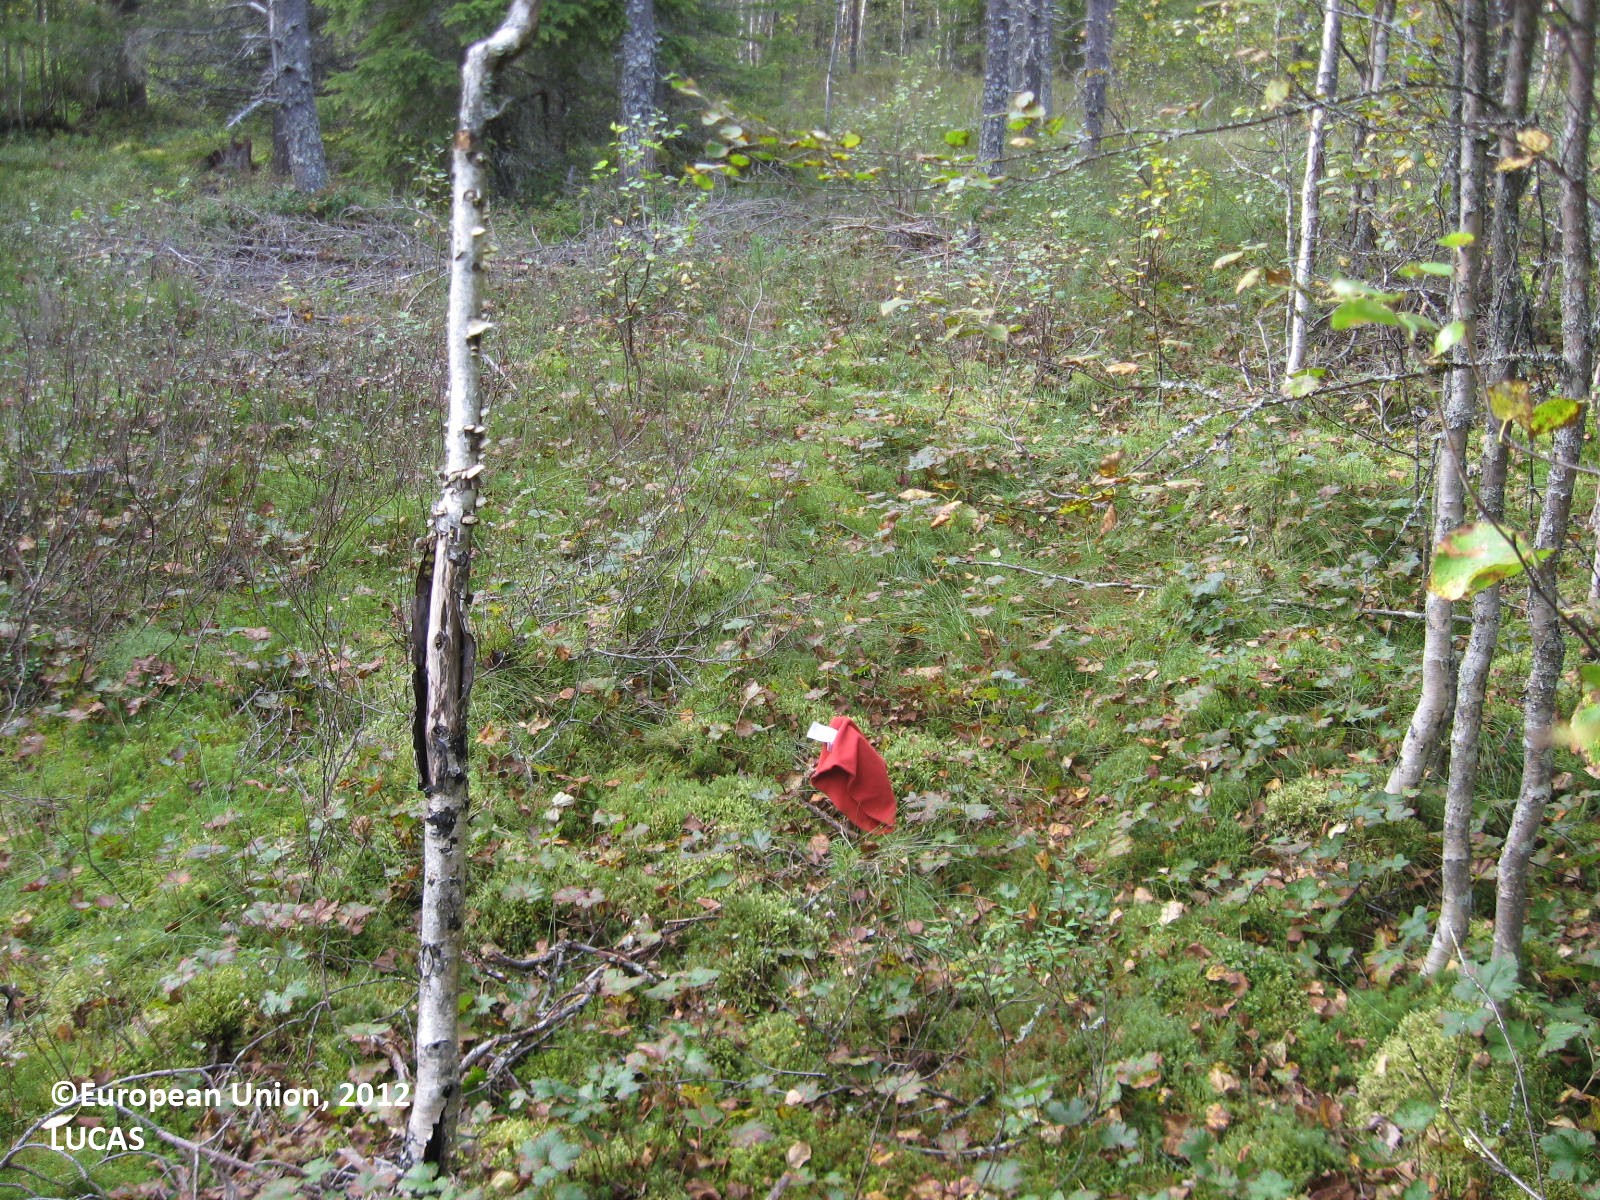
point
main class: Woodland
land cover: Other coniferous woodland
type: boreal forest
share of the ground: > 75 %
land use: Forestry
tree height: > 5 m
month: August
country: FI
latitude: 63.8155
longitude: 29.1186
